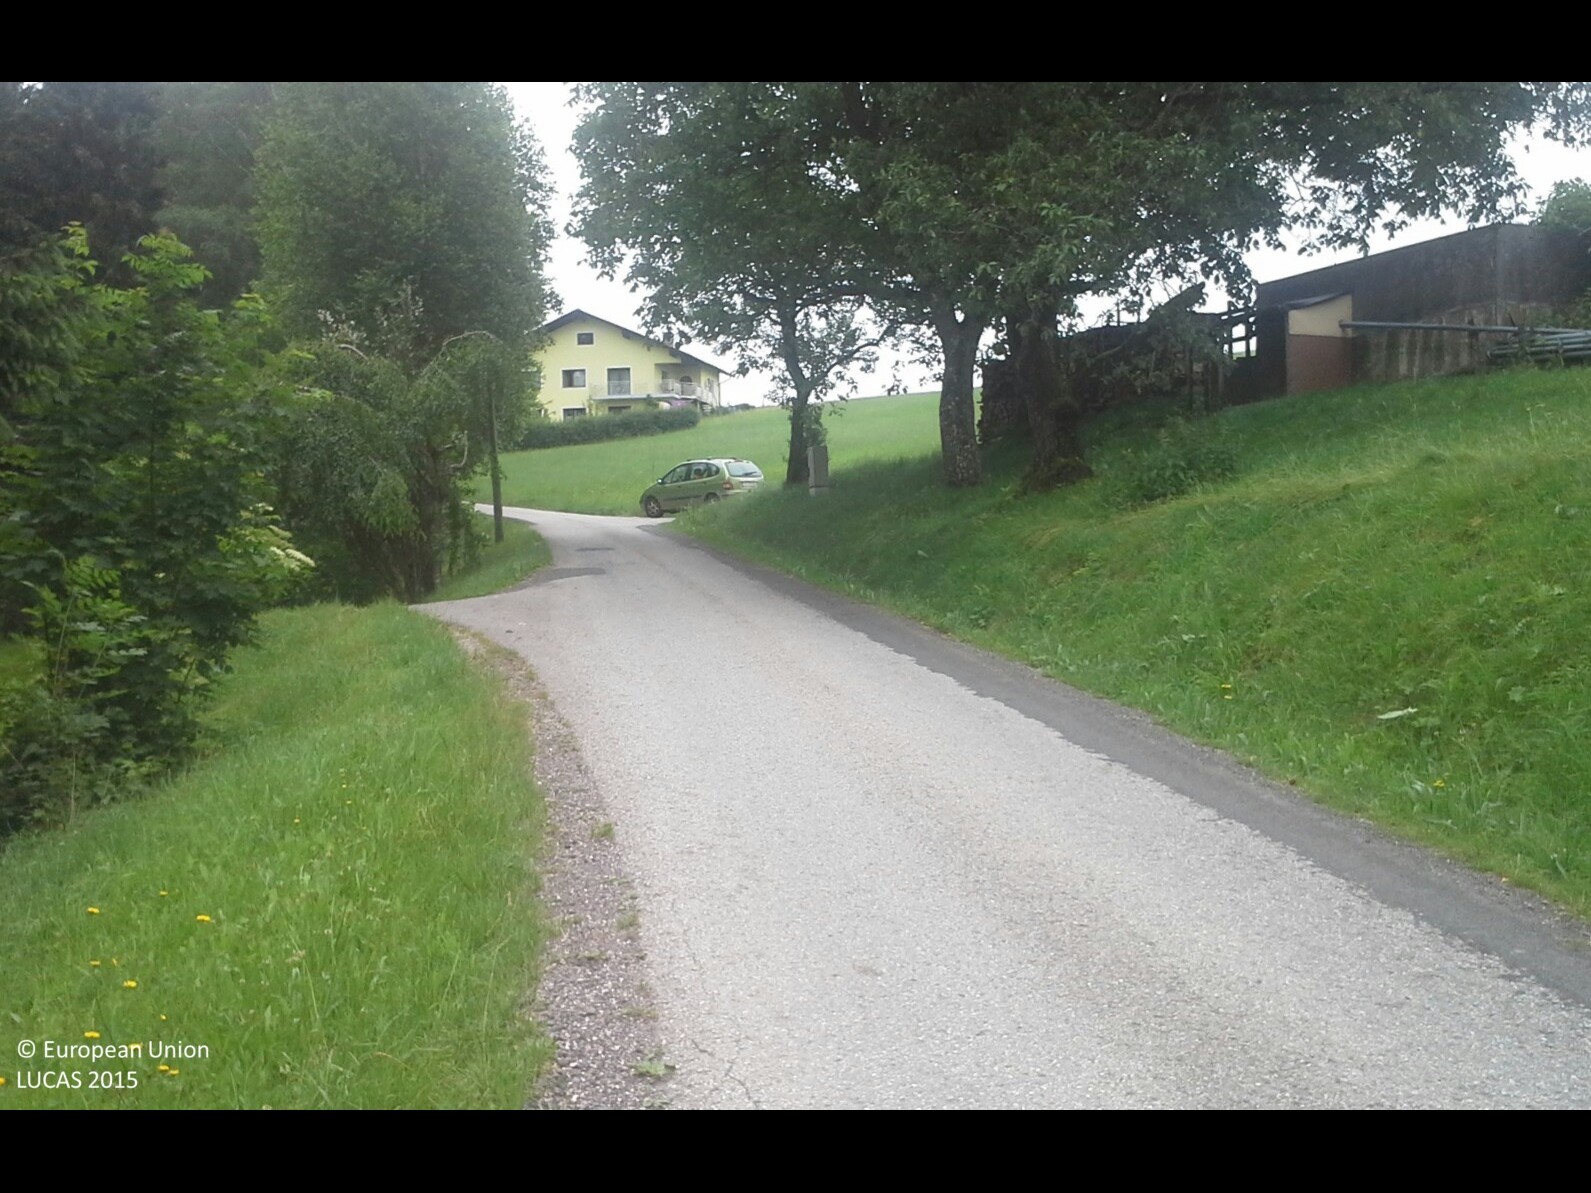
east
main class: Grassland
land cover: Grassland without tree/shrub cover
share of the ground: > 75 %
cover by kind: herbaceous plants 100 %
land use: Agriculture (excluding fallow land and kitchen gardens)
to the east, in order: Grassland without tree/shrub cover; Paved roads, cycling and walking lanes; Ditches and canals; Grassland without tree/shrub cover; Artificial constructions in urban areas; Grassland with sparse tree/shrub cover; Paved roads, cycling and walking lanes; Grassland without tree/shrub cover
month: June
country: AT
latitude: 47.9775
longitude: 14.3001
